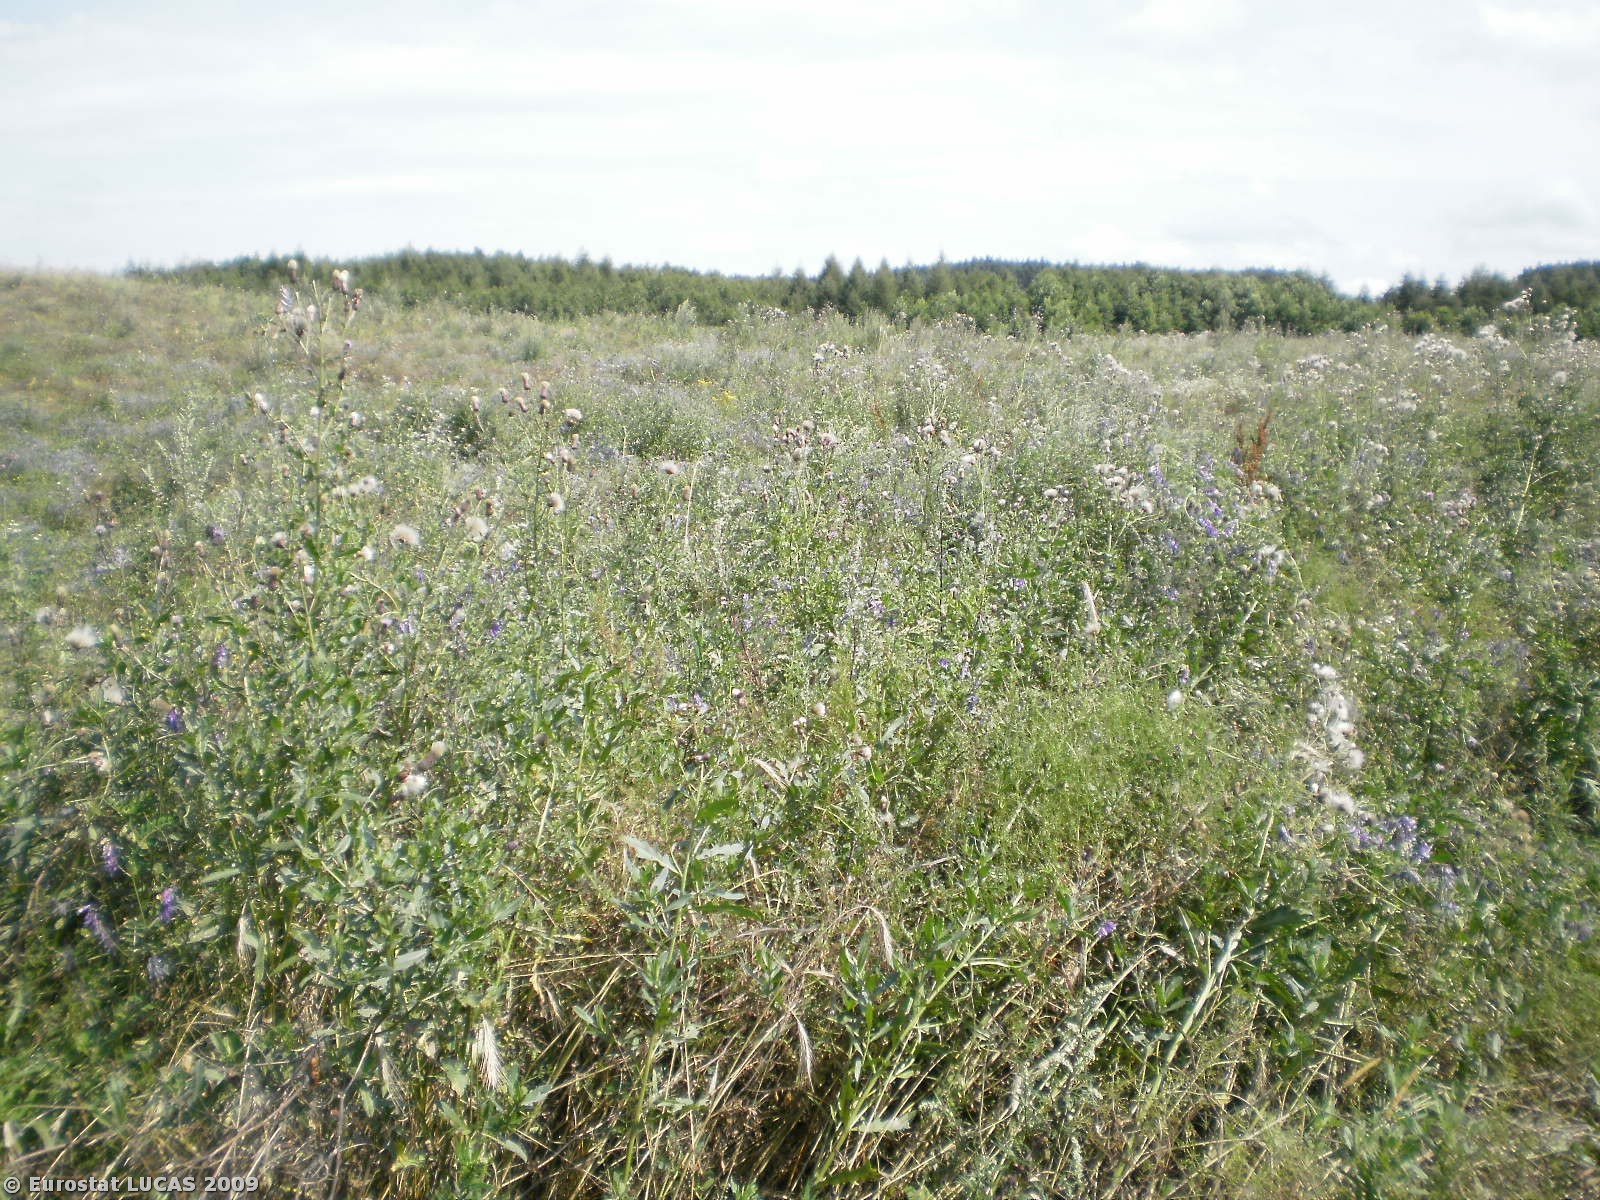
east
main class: Shrubland
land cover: Shrubland with sparse tree cover
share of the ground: > 75 %
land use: Unused
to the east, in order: Shrubland with sparse tree cover; Spontaneously vegetated surfaces
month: July
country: PL
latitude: 53.8929
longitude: 20.6444
